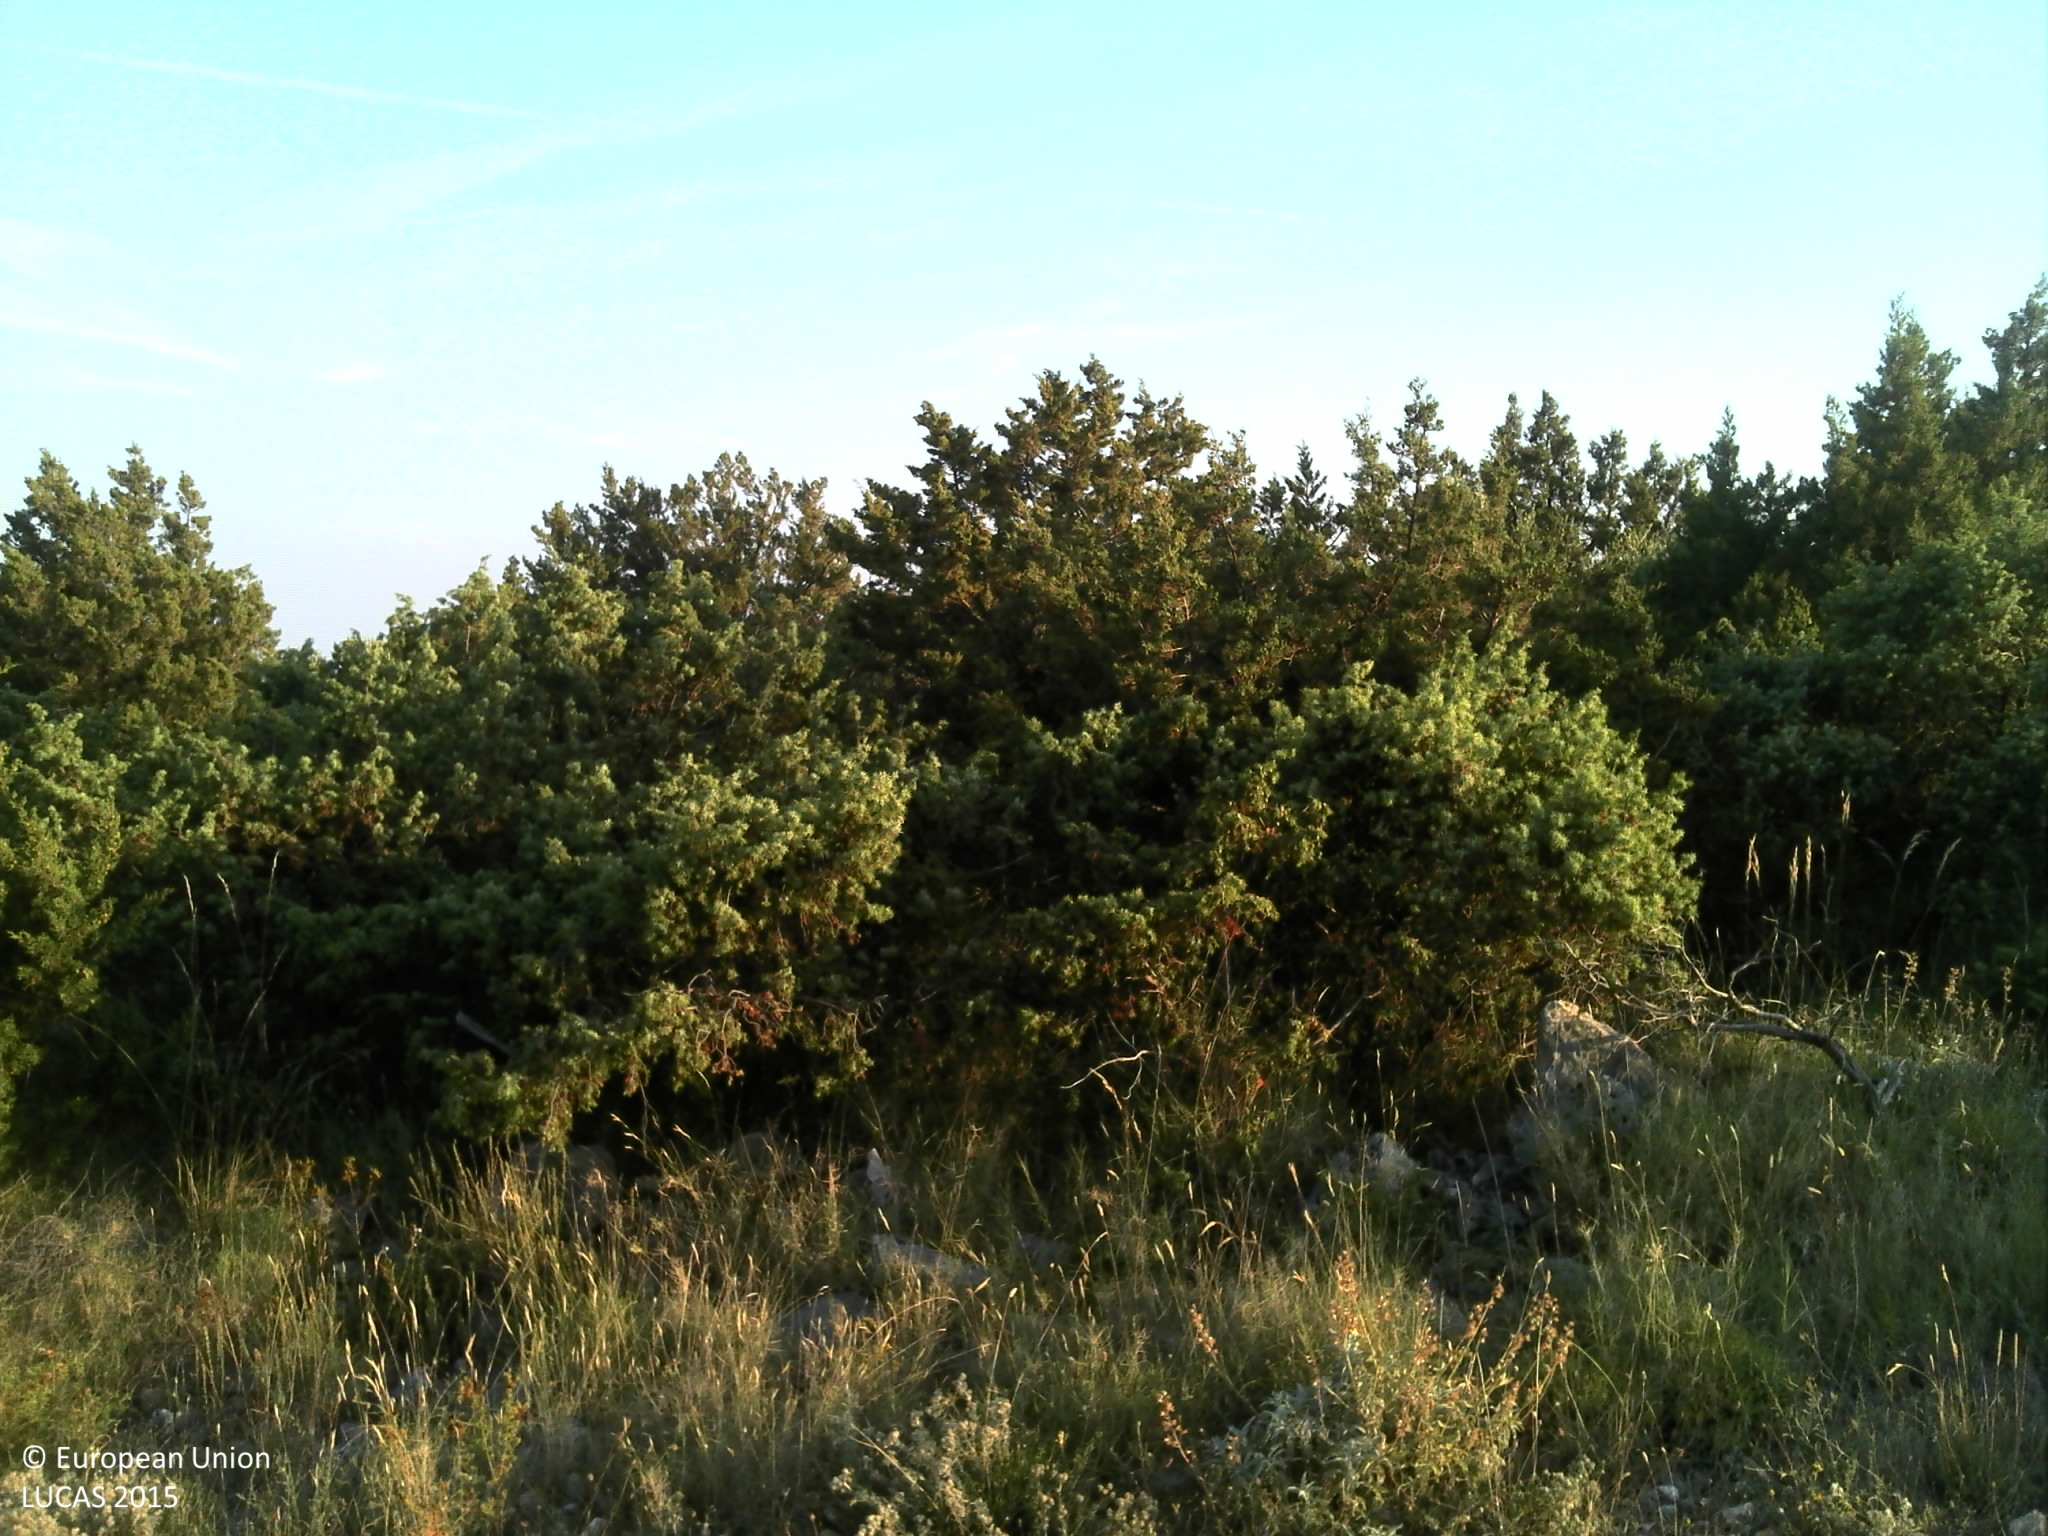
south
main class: Shrubland
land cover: Shrubland without tree cover
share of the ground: 50 - 75 %
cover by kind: shrubs 70 %, herbaceous plants 20 %, consolidated bare surface 5 %, unconsolidated bare surface 5 %
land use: Semi-natural and natural areas not in use
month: July
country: HR
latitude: 43.4861
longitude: 16.3584
